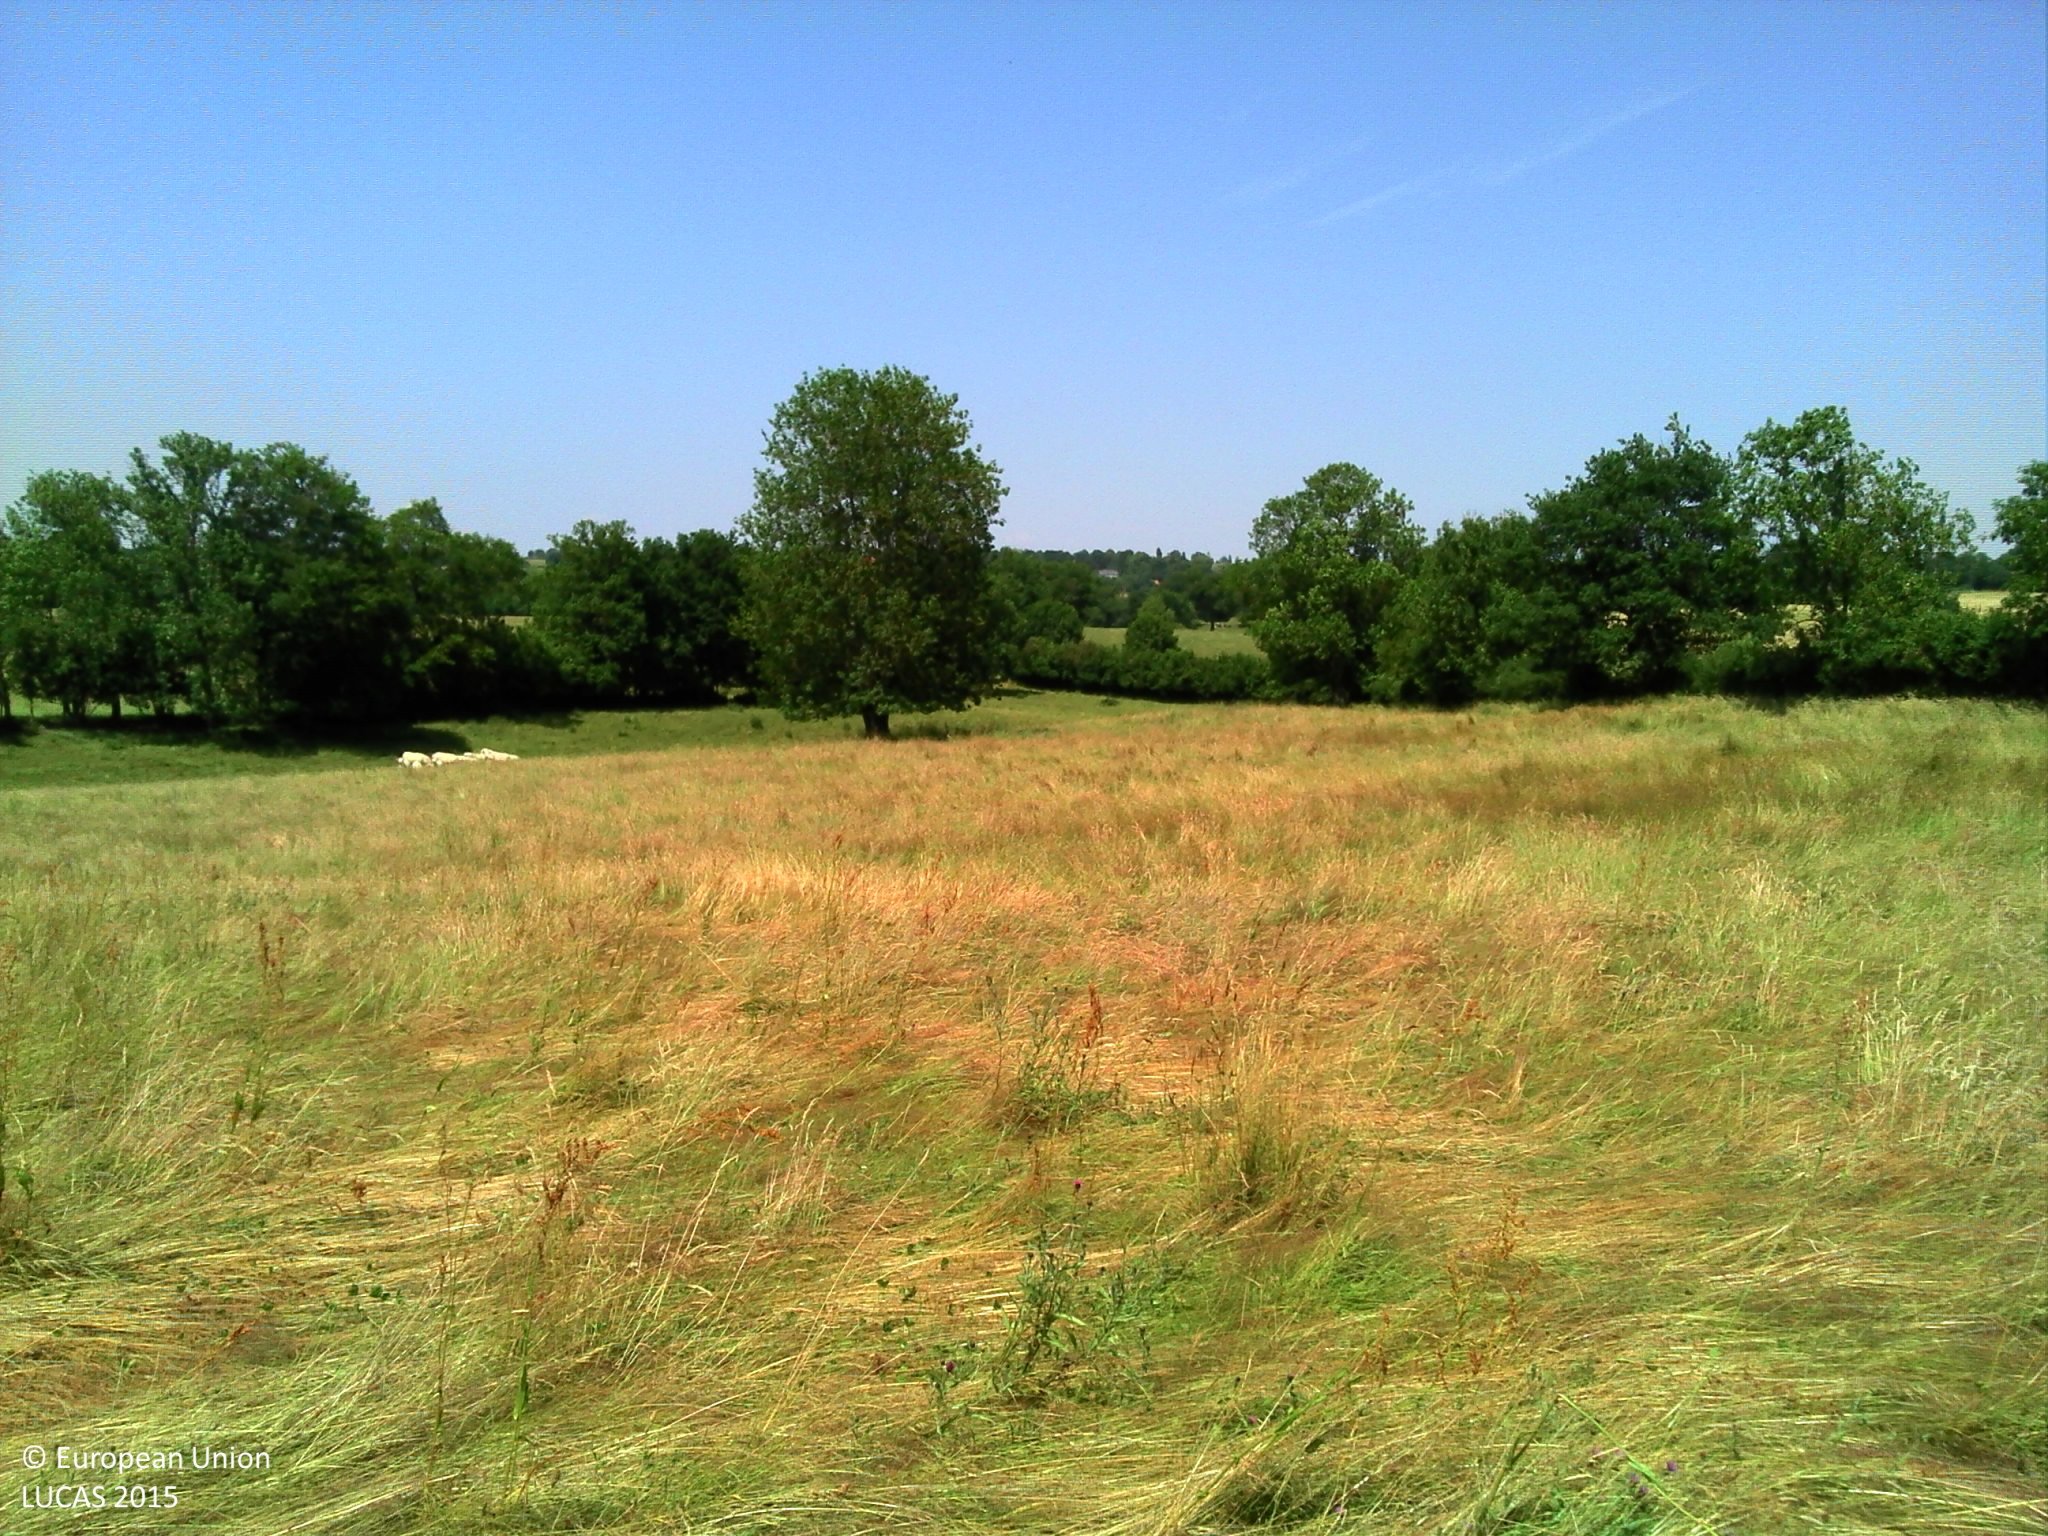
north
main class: Grassland
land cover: Grassland without tree/shrub cover
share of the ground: > 75 %
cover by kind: herbaceous plants 100 %
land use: Agriculture (excluding fallow land and kitchen gardens)
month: June
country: FR
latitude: 46.3400
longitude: 3.0209
